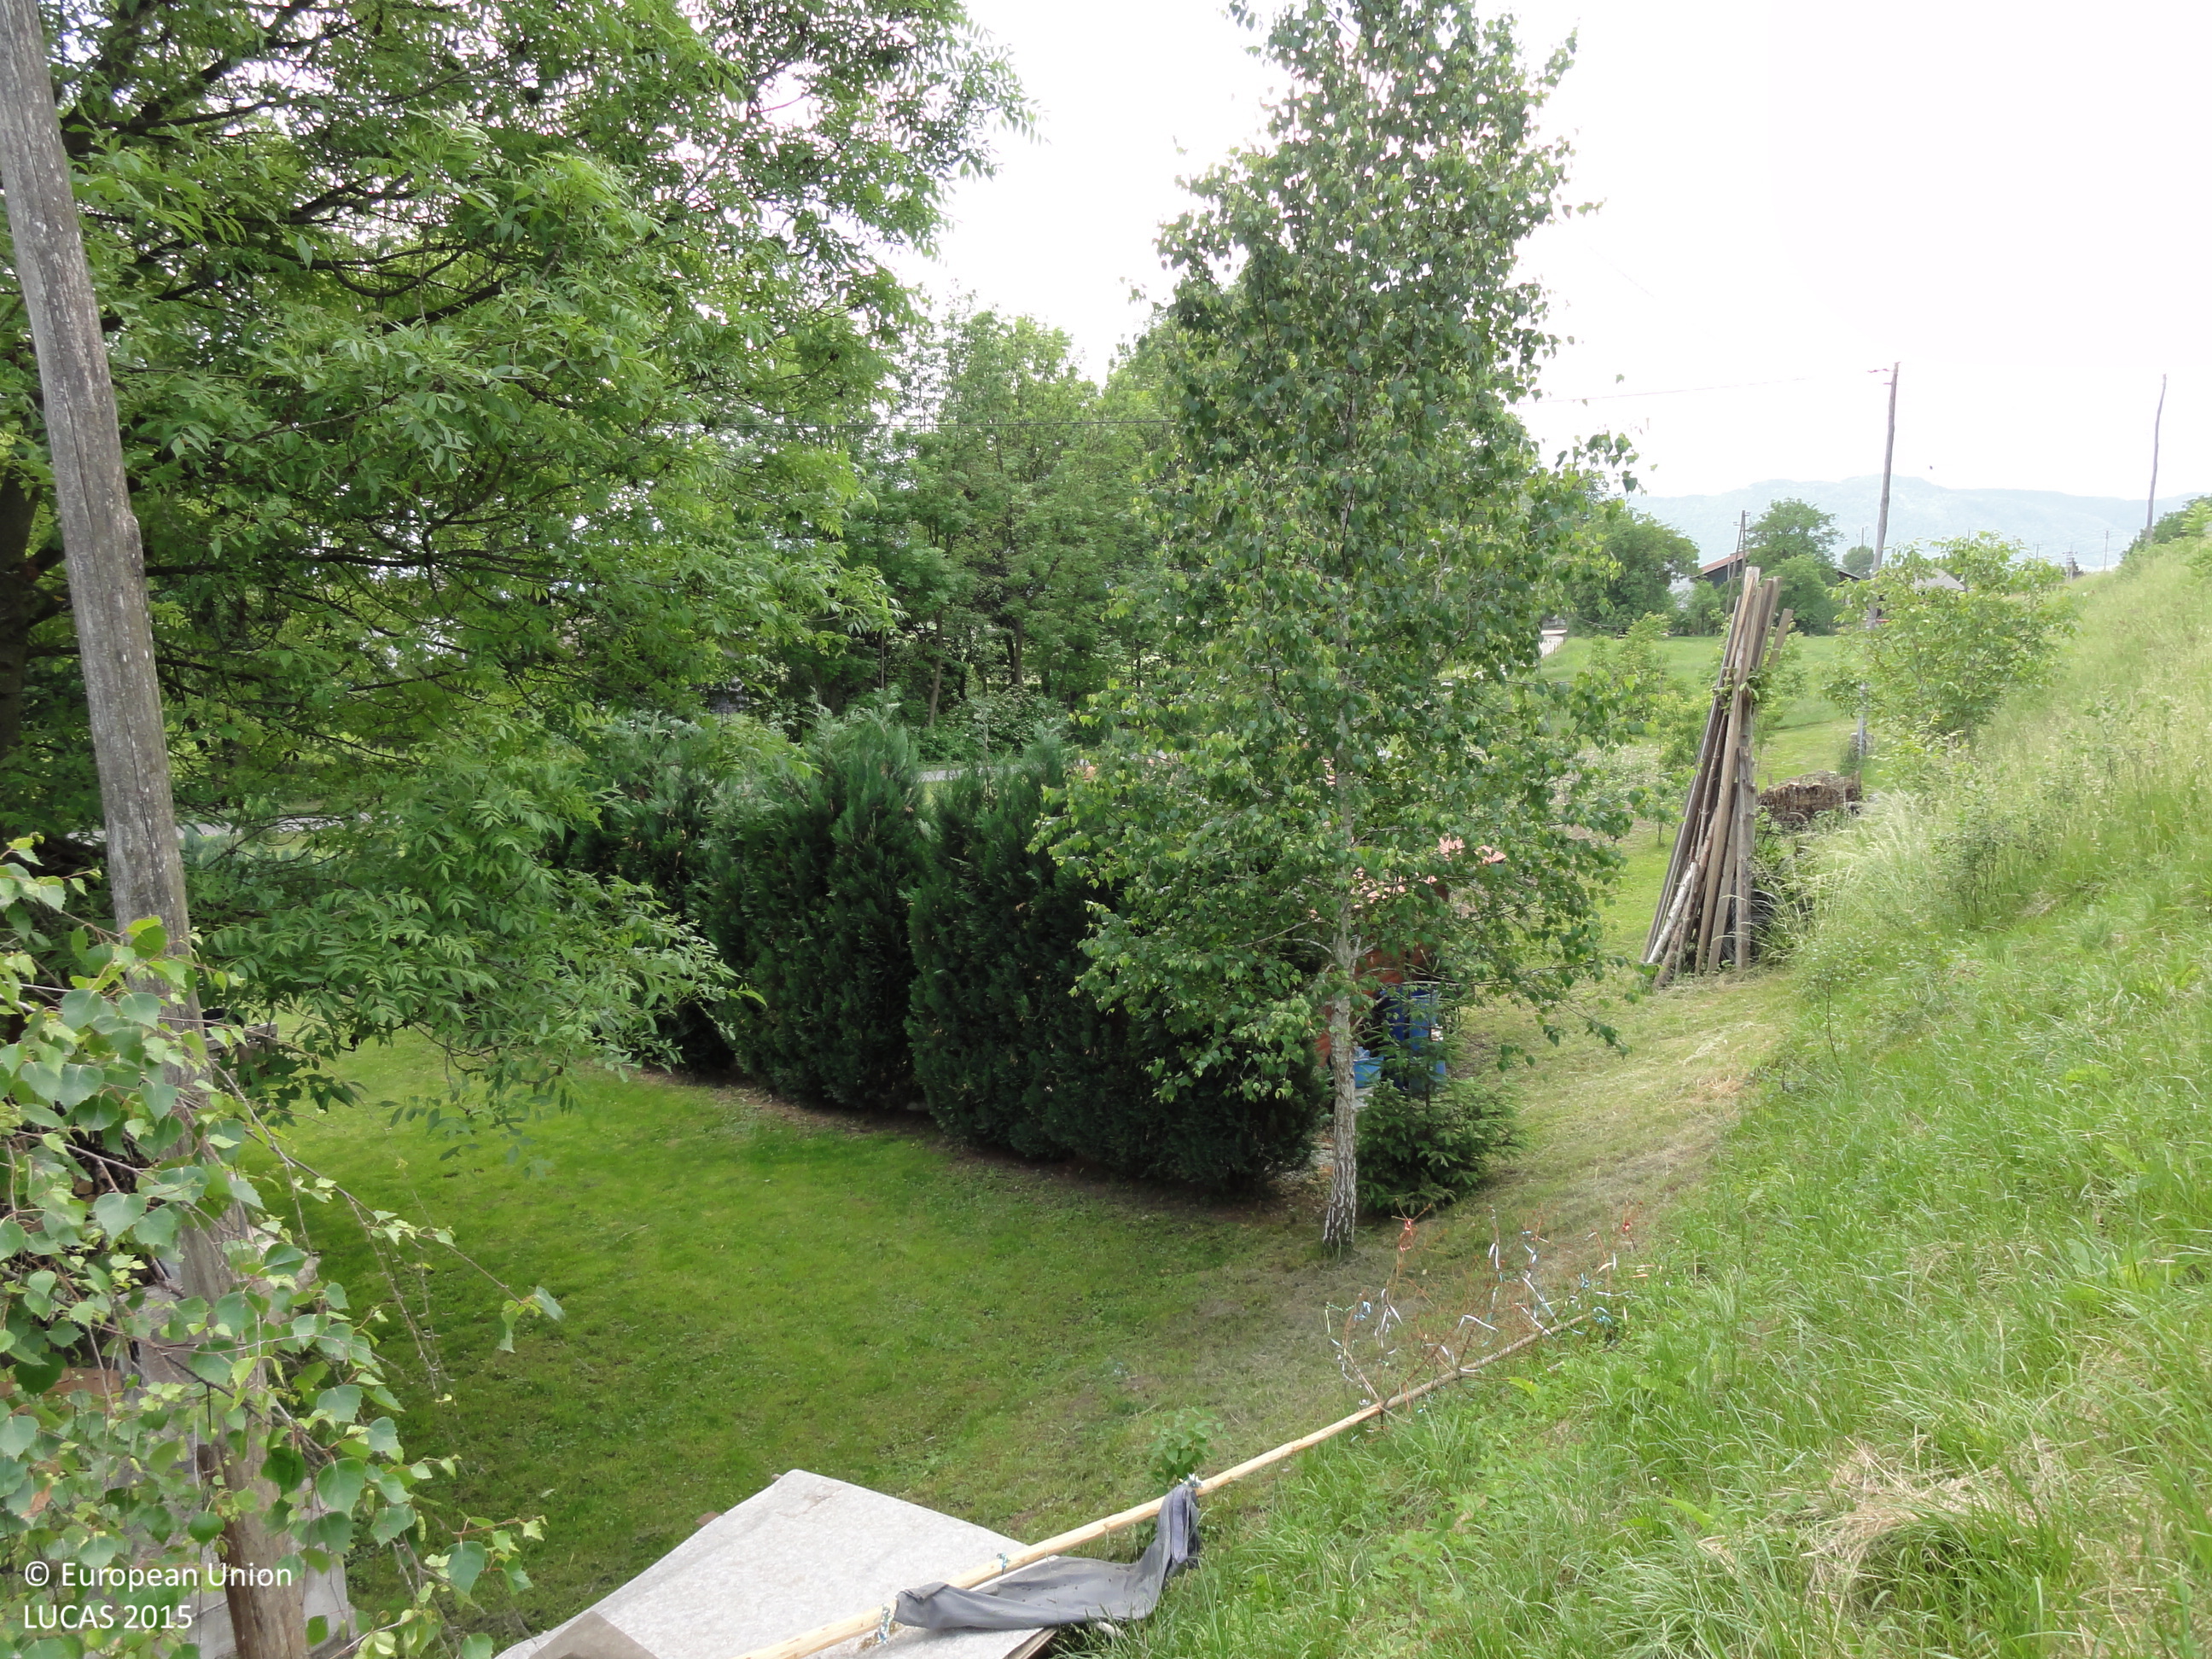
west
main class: Grassland
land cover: Grassland with sparse tree/shrub cover
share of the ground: > 75 %
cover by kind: herbaceous plants 90 %, broadleaved forest trees 5 %, shrubs 5 %
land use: Residential
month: May
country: SI
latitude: 46.2658
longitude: 15.0966
